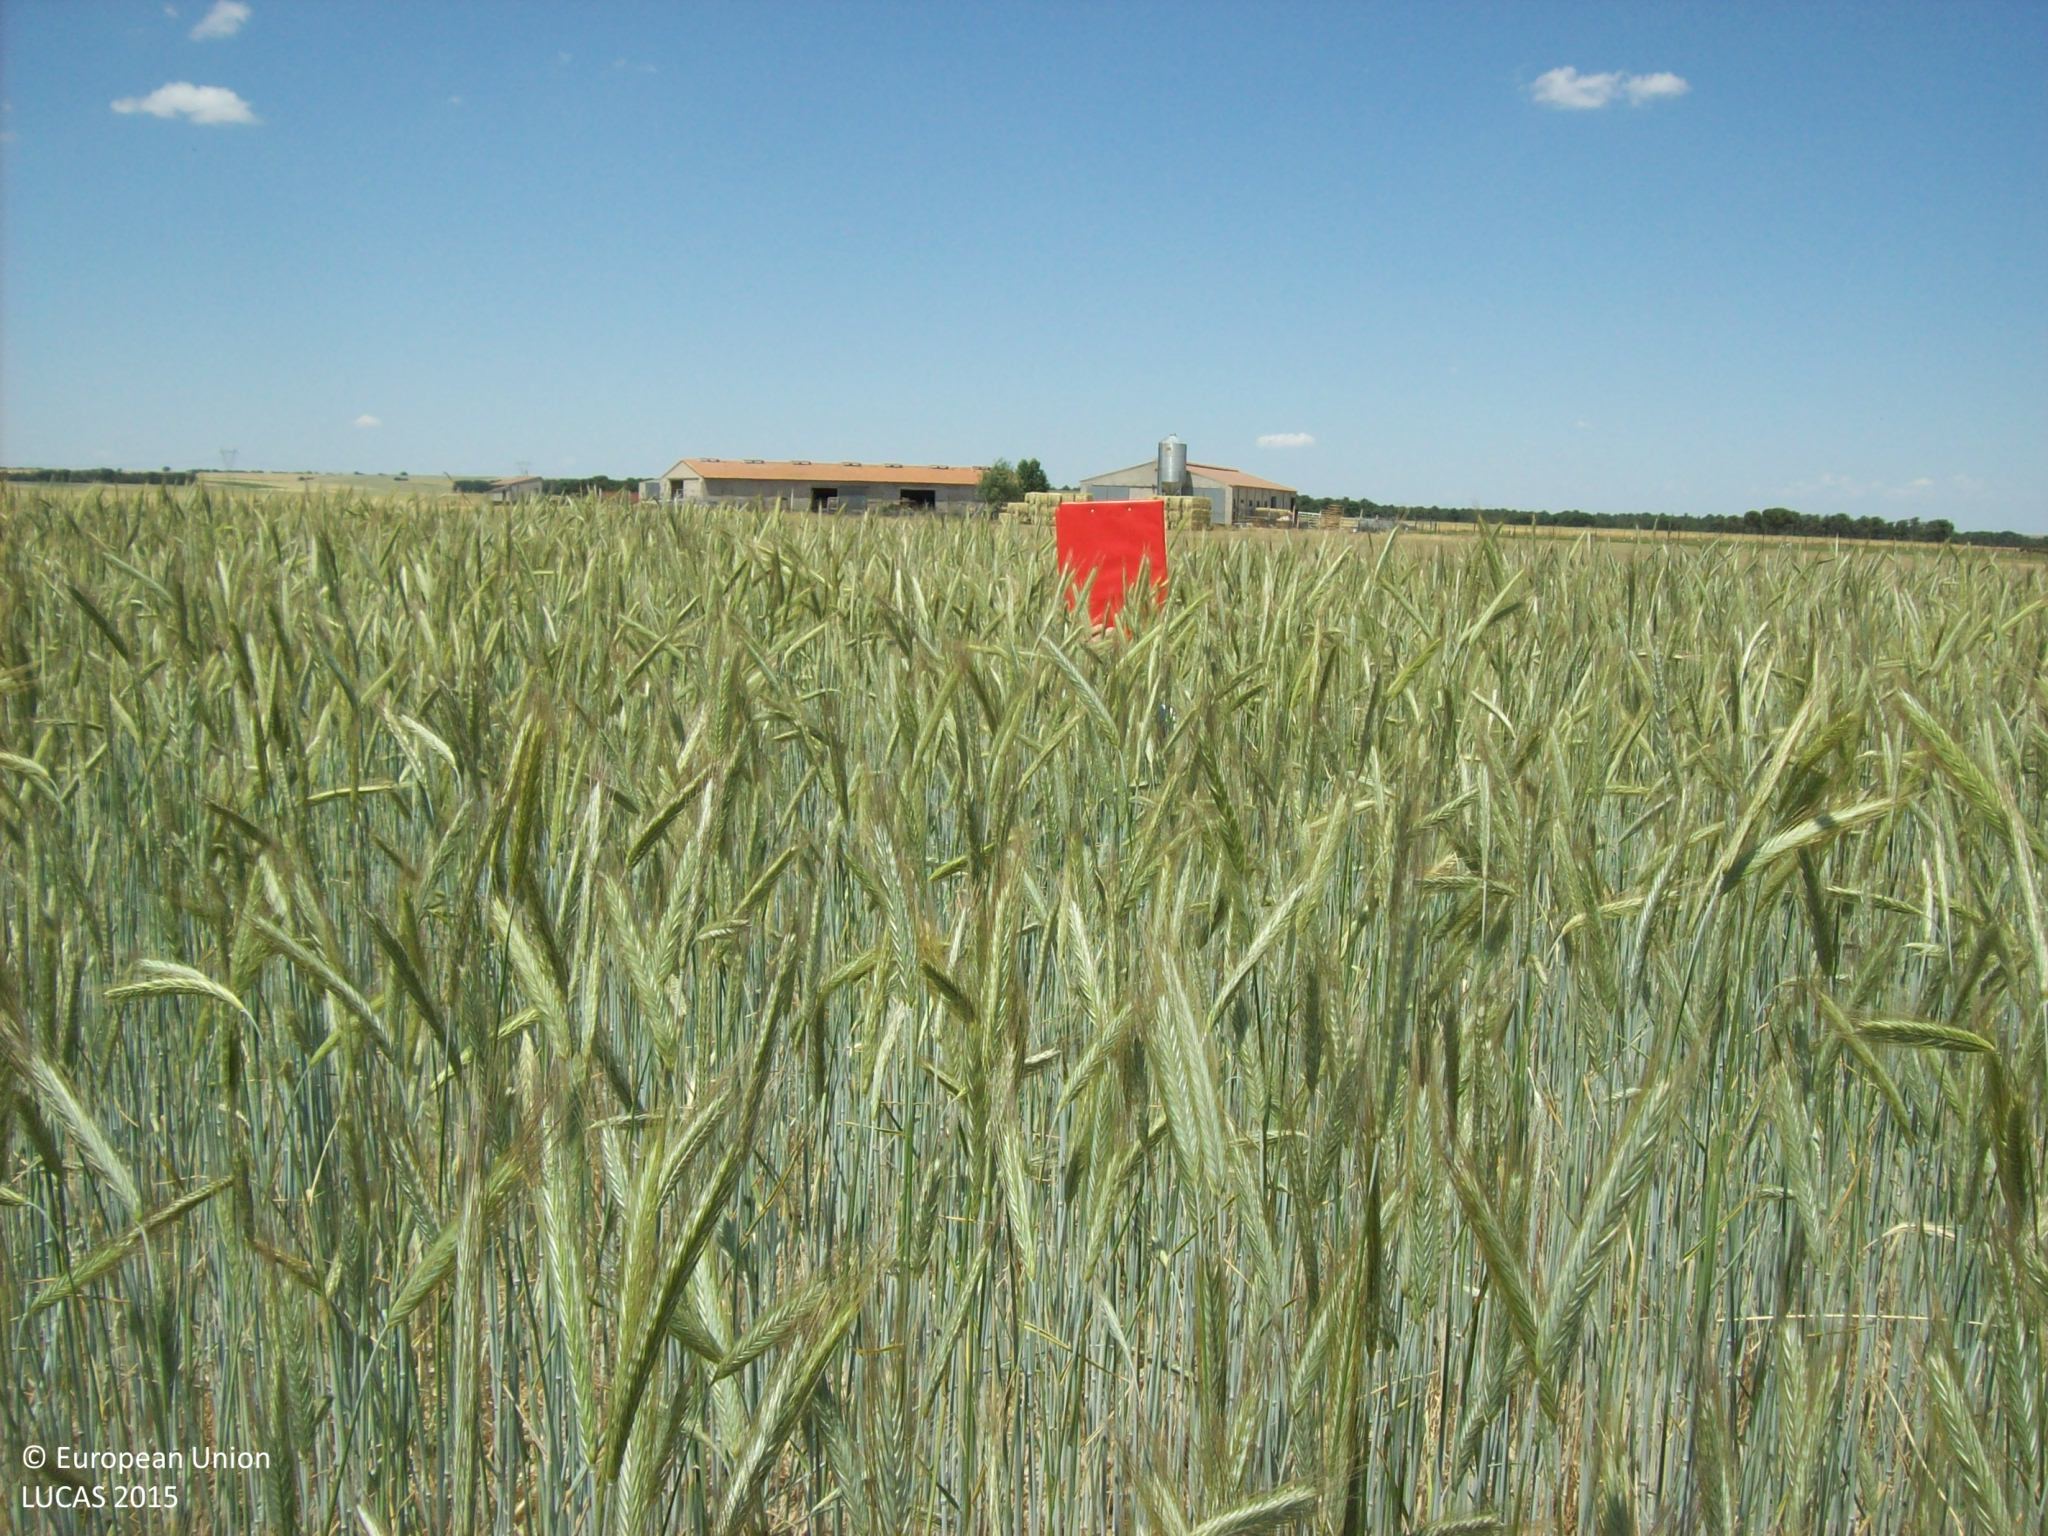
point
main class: Cropland
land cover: Rye
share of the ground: > 75 %
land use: Agriculture (excluding fallow land and kitchen gardens)
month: June
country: ES
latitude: 41.0879
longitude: -4.5222
